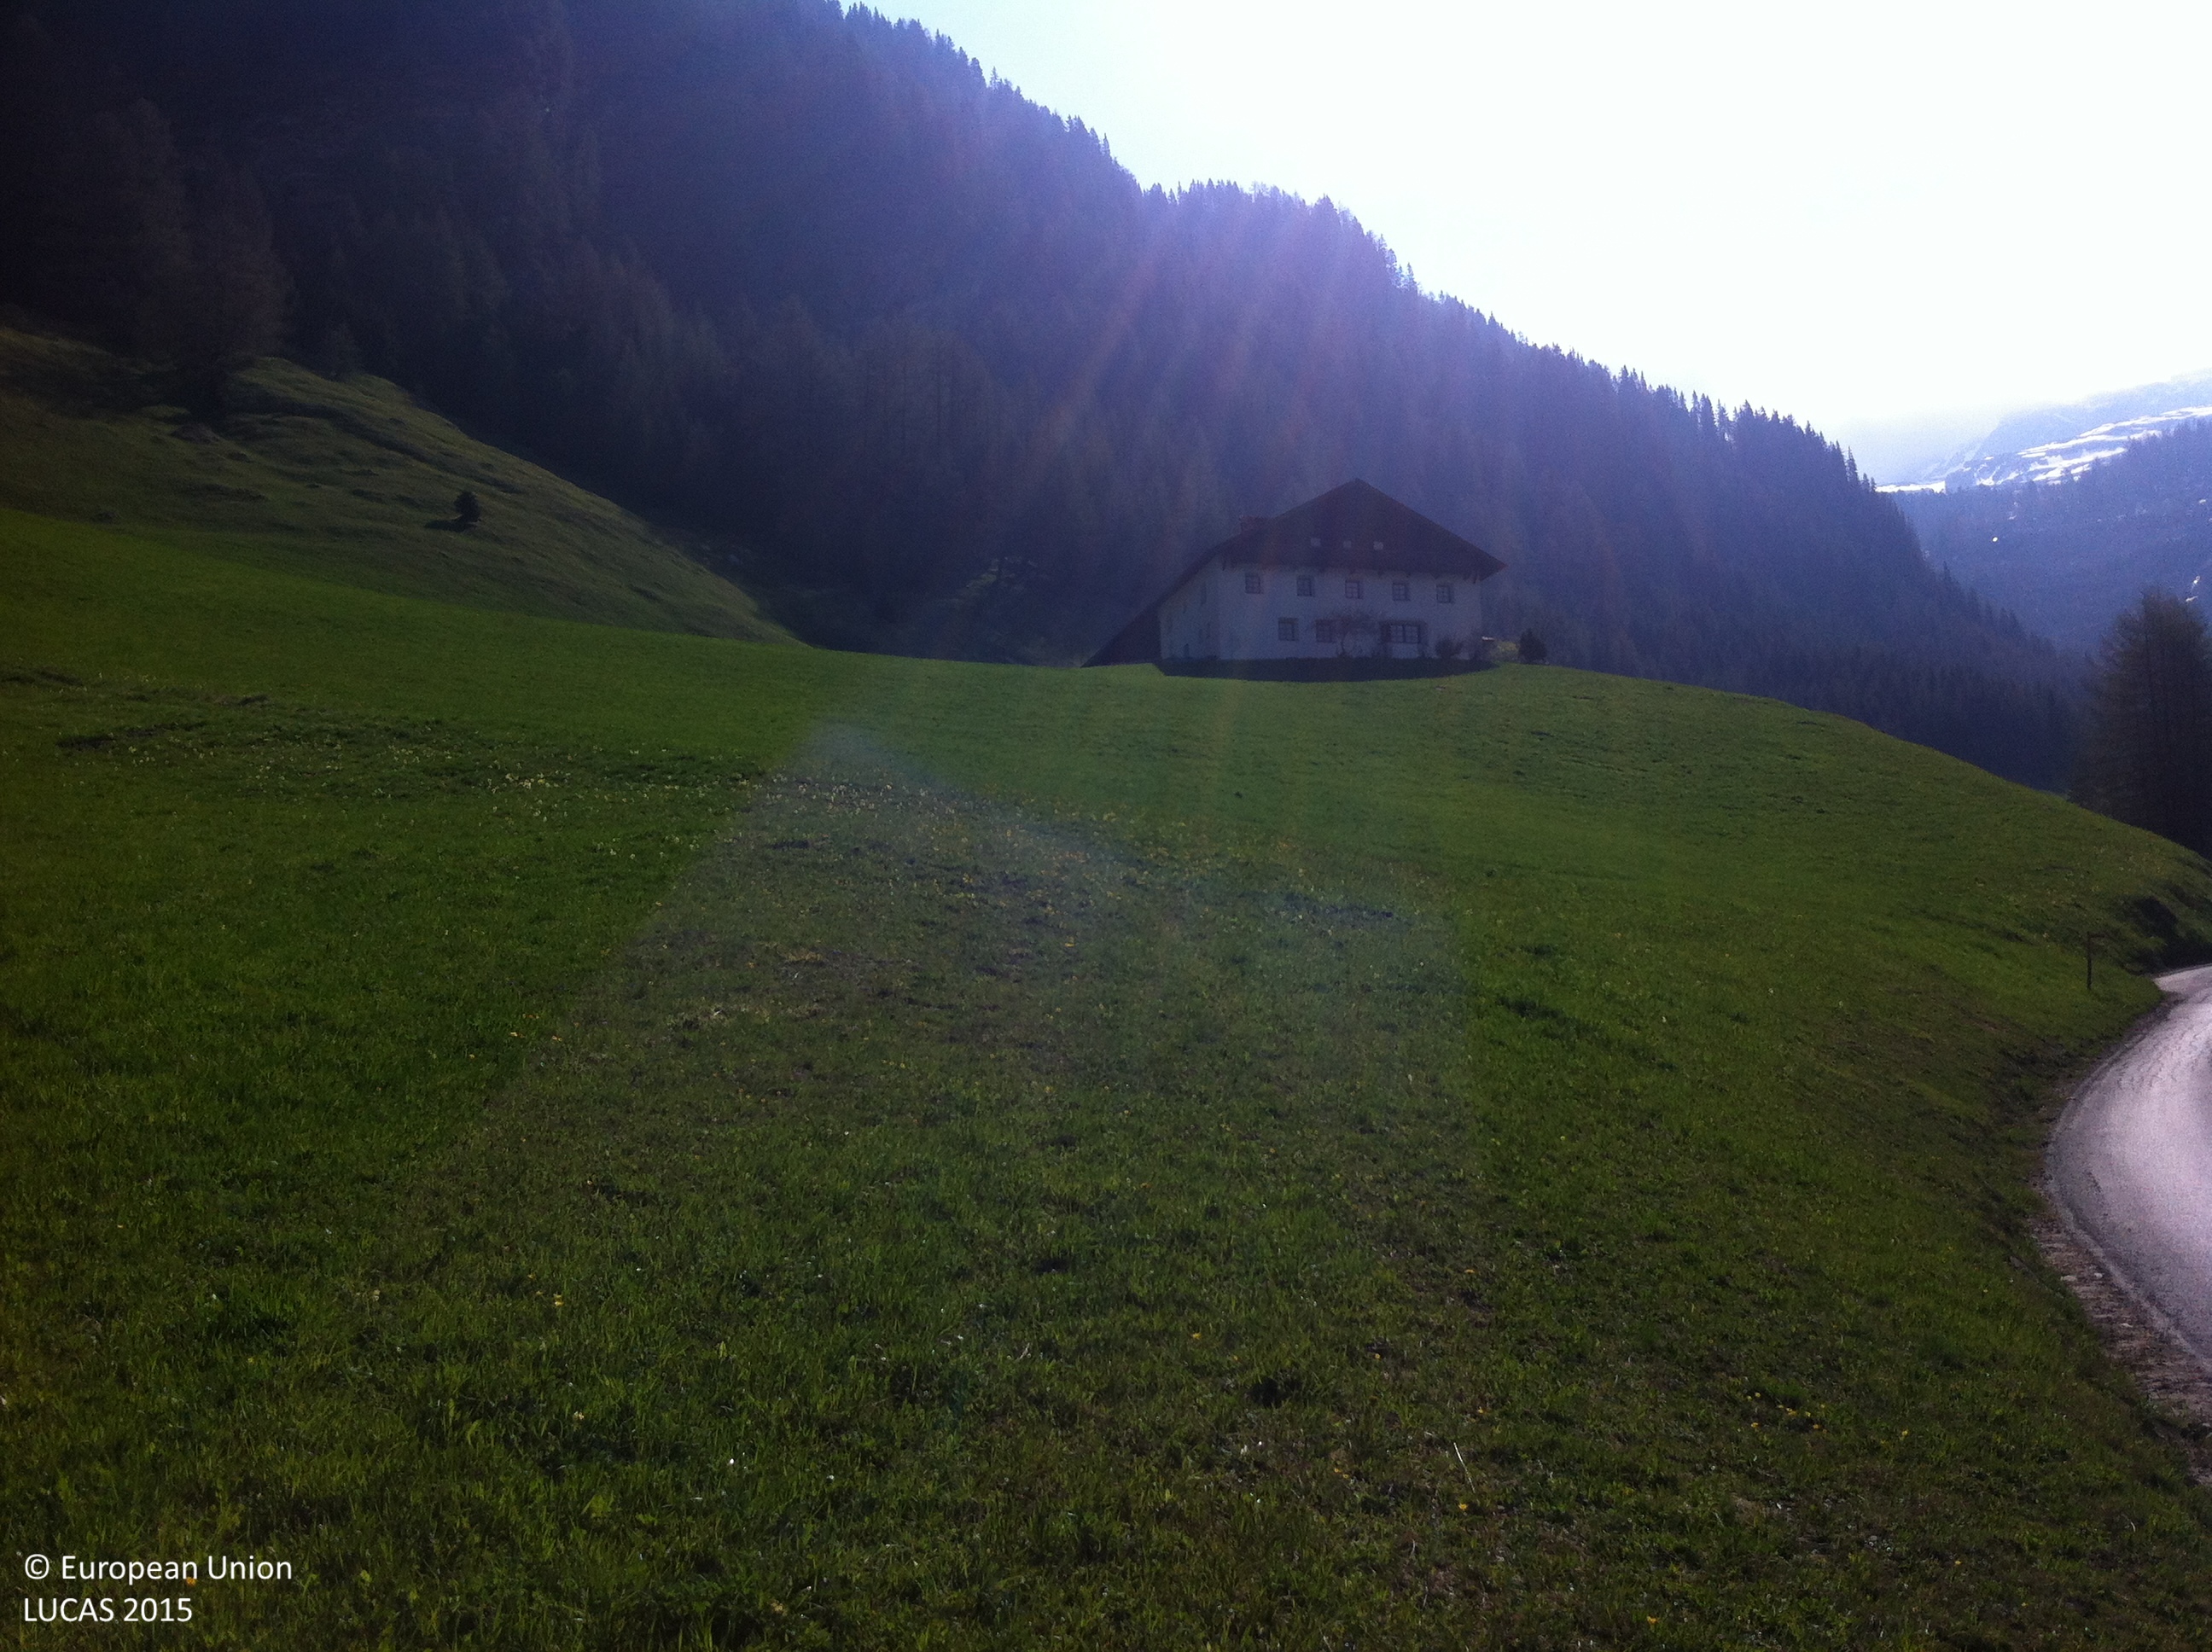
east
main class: Grassland
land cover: Grassland without tree/shrub cover
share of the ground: > 75 %
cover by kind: herbaceous plants 100 %
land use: Agriculture (excluding fallow land and kitchen gardens)
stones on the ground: < 10 %
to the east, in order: Grassland without tree/shrub cover; Single bushes/trees; Grassland without tree/shrub cover; Single bushes/trees; Grassland without tree/shrub cover; Other mixed woodland
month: May
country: AT
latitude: 47.0070
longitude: 11.5111
